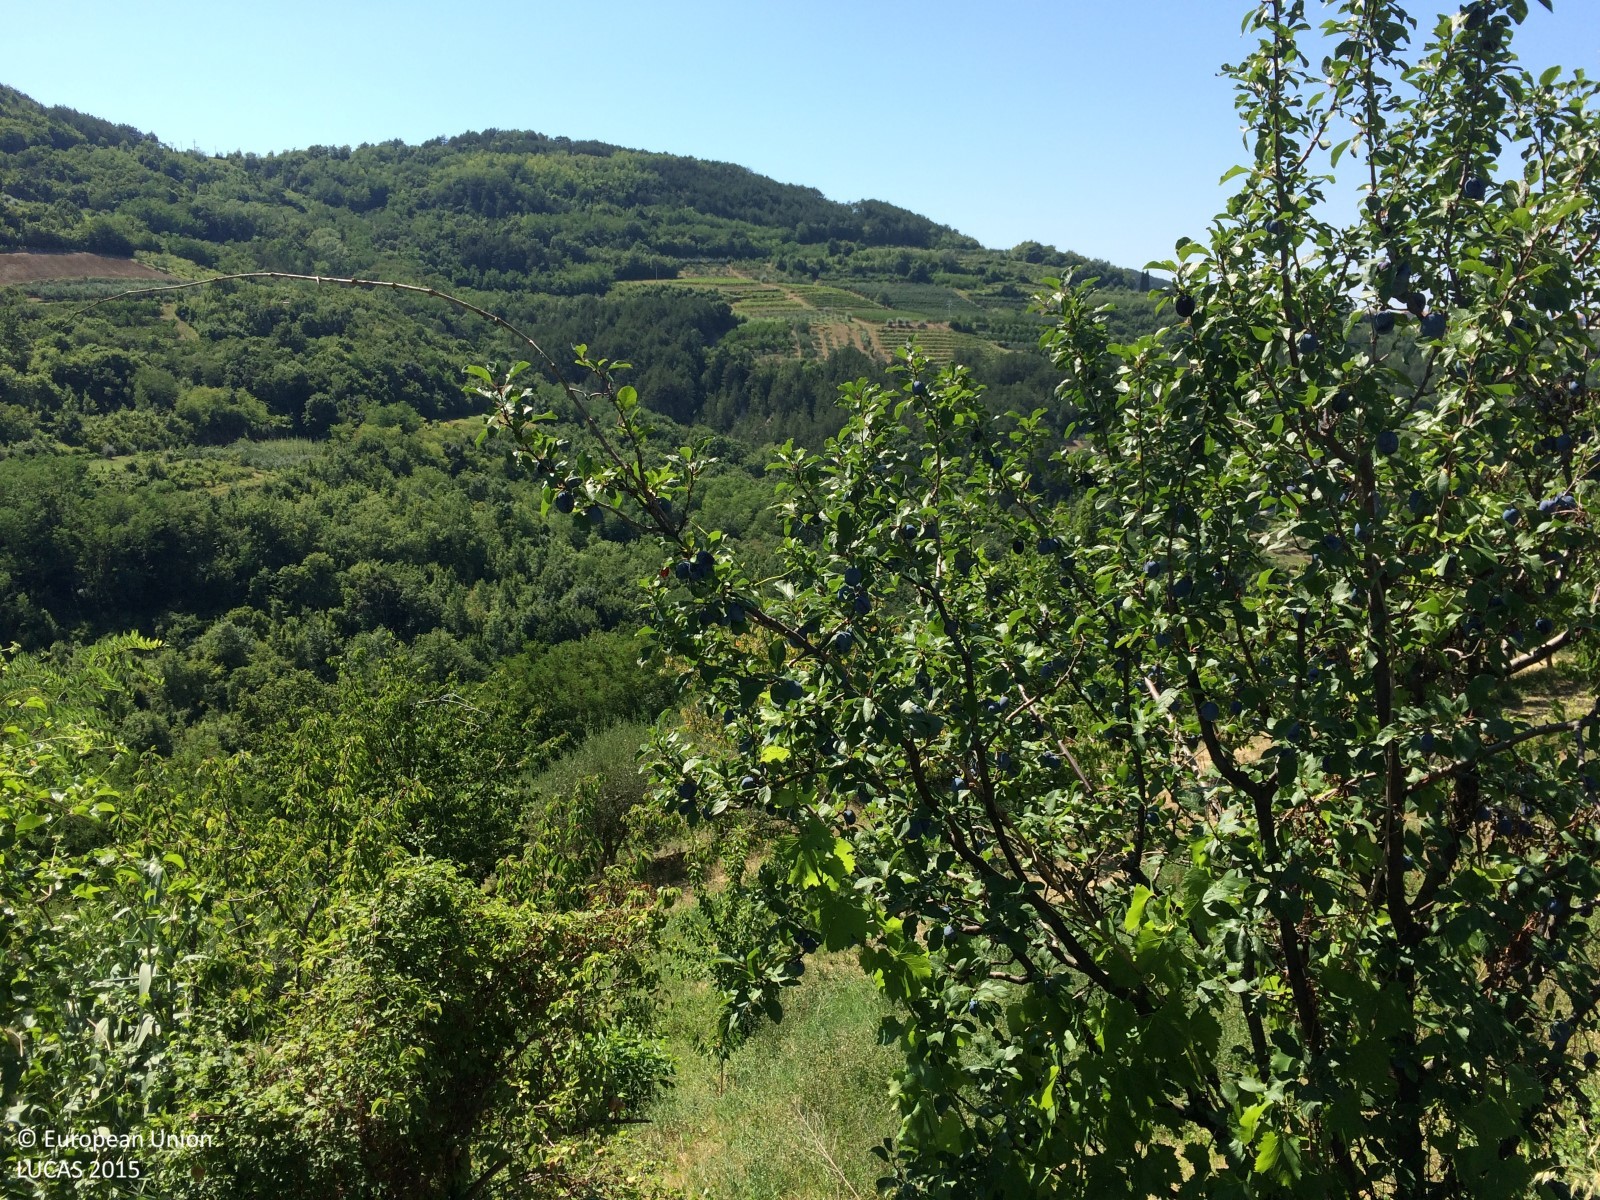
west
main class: Grassland
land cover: Grassland with sparse tree/shrub cover
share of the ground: 25 - 50 %
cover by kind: herbaceous plants 90 %, broadleaved forest trees 5 %, shrubs 5 %
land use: Abandoned areas
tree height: < 5 m
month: July
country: HR
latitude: 45.3076
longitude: 13.8595
